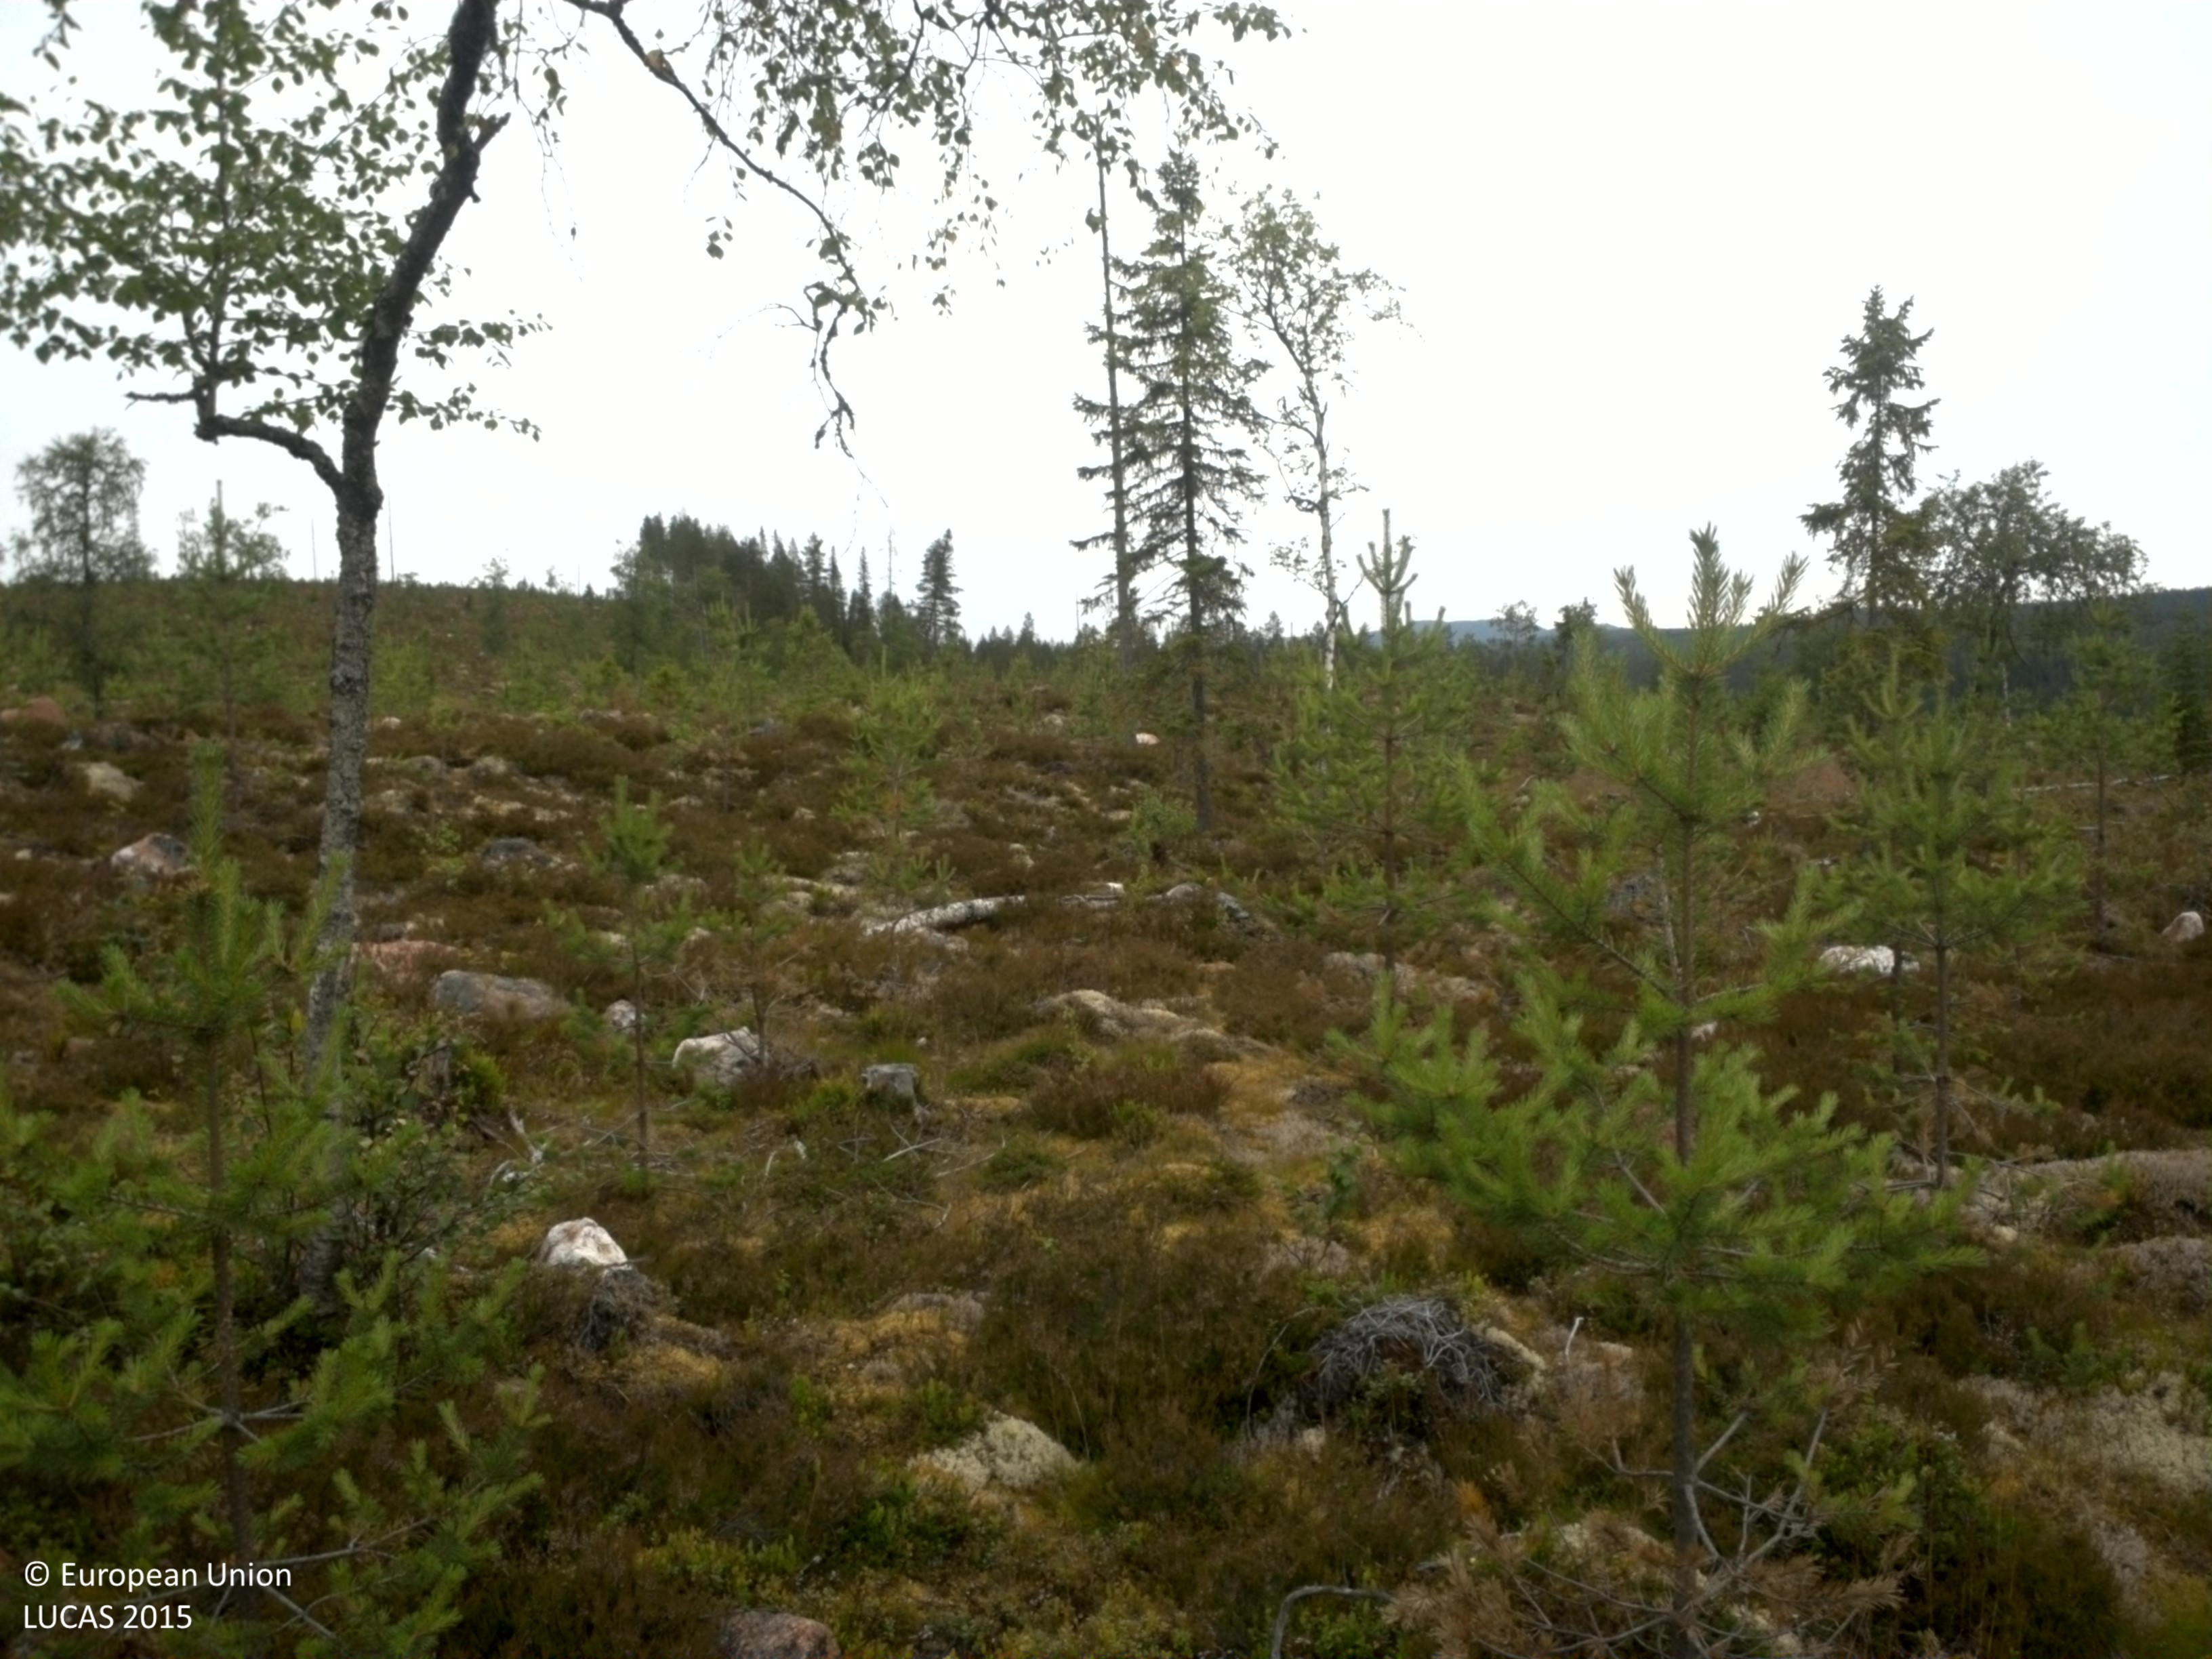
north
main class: Woodland
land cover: Pine dominated coniferous woodland
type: boreal forest
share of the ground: 10 - 25 %
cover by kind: shrubs 40 %, coniferous forest trees 20 %, consolidated bare surface 20 %, lichens and mosses 10 %, broadleaved forest trees 5 %, herbaceous plants 5 %
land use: Forestry
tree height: < 5 m
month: August
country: SE
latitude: 61.5762
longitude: 14.2979
